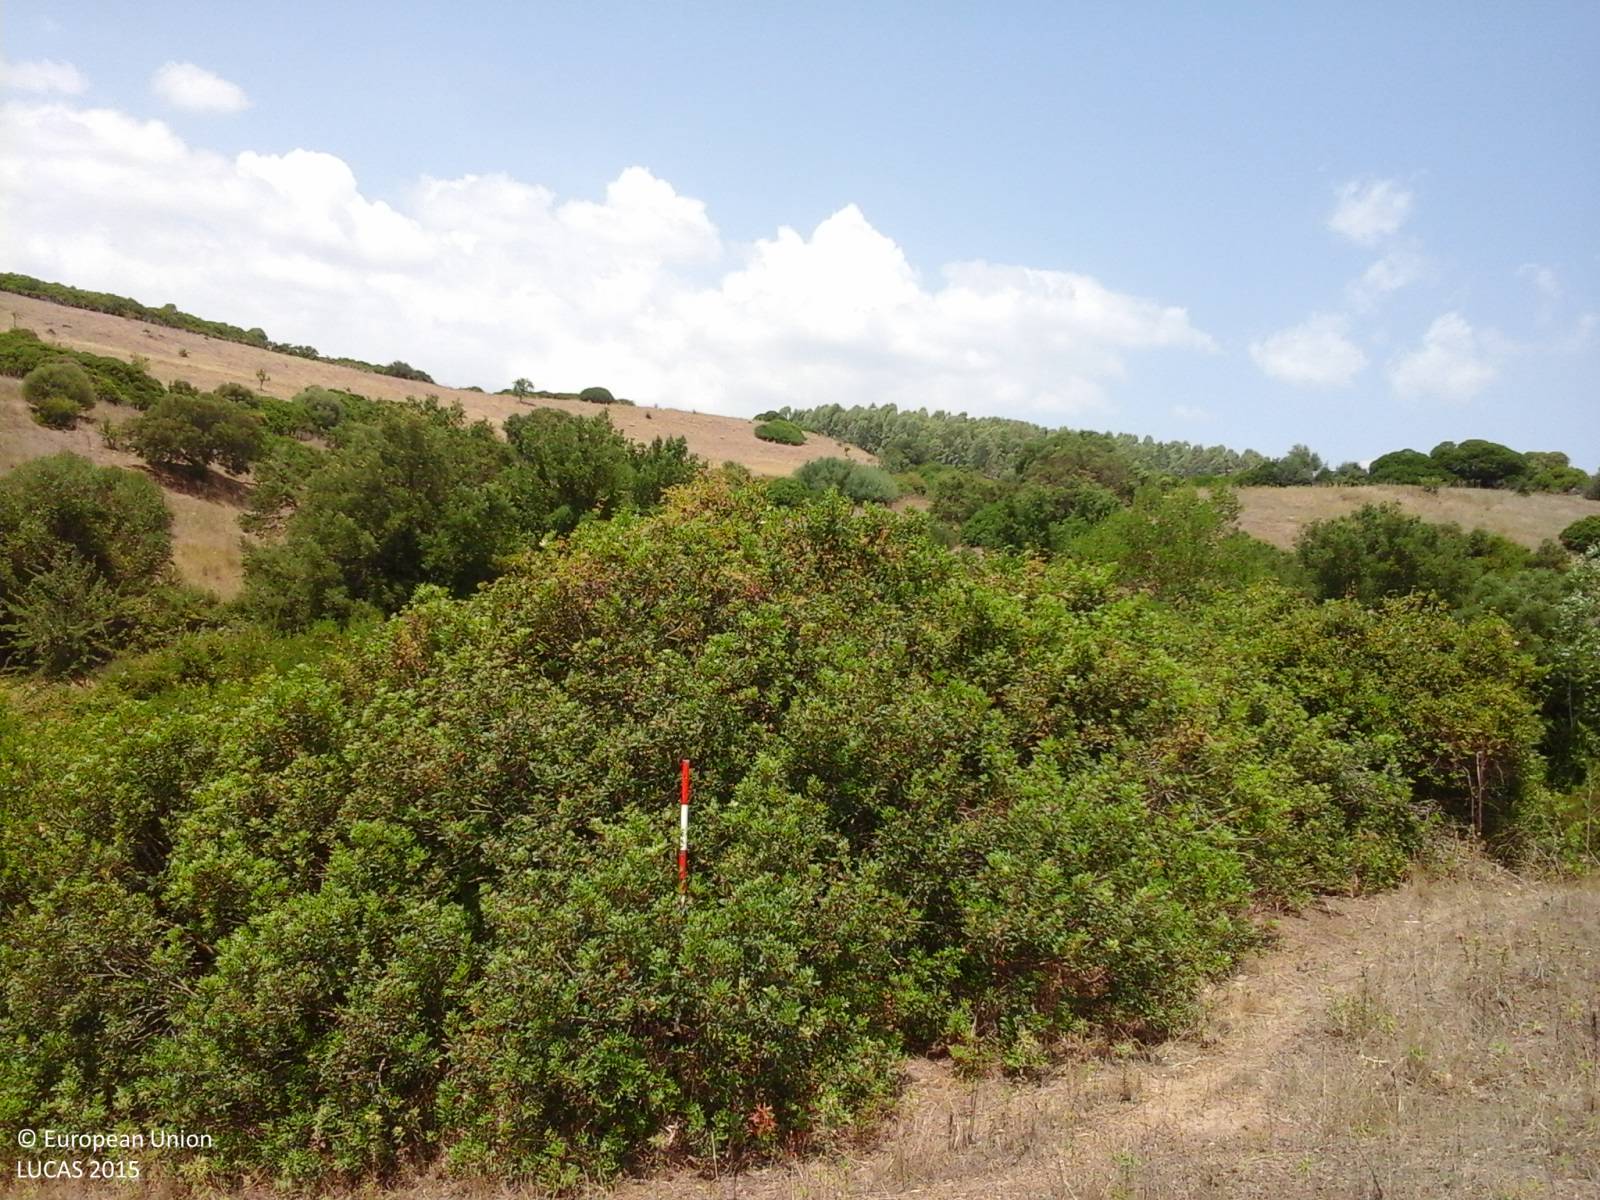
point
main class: Woodland
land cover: Broadleaved woodland
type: thermophilous deciduous forest
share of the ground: 25 - 50 %
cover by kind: broadleaved forest trees 65 %, shrubs 35 %
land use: Forestry
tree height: < 5 m
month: July
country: IT
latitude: 39.9895
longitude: 8.8935
